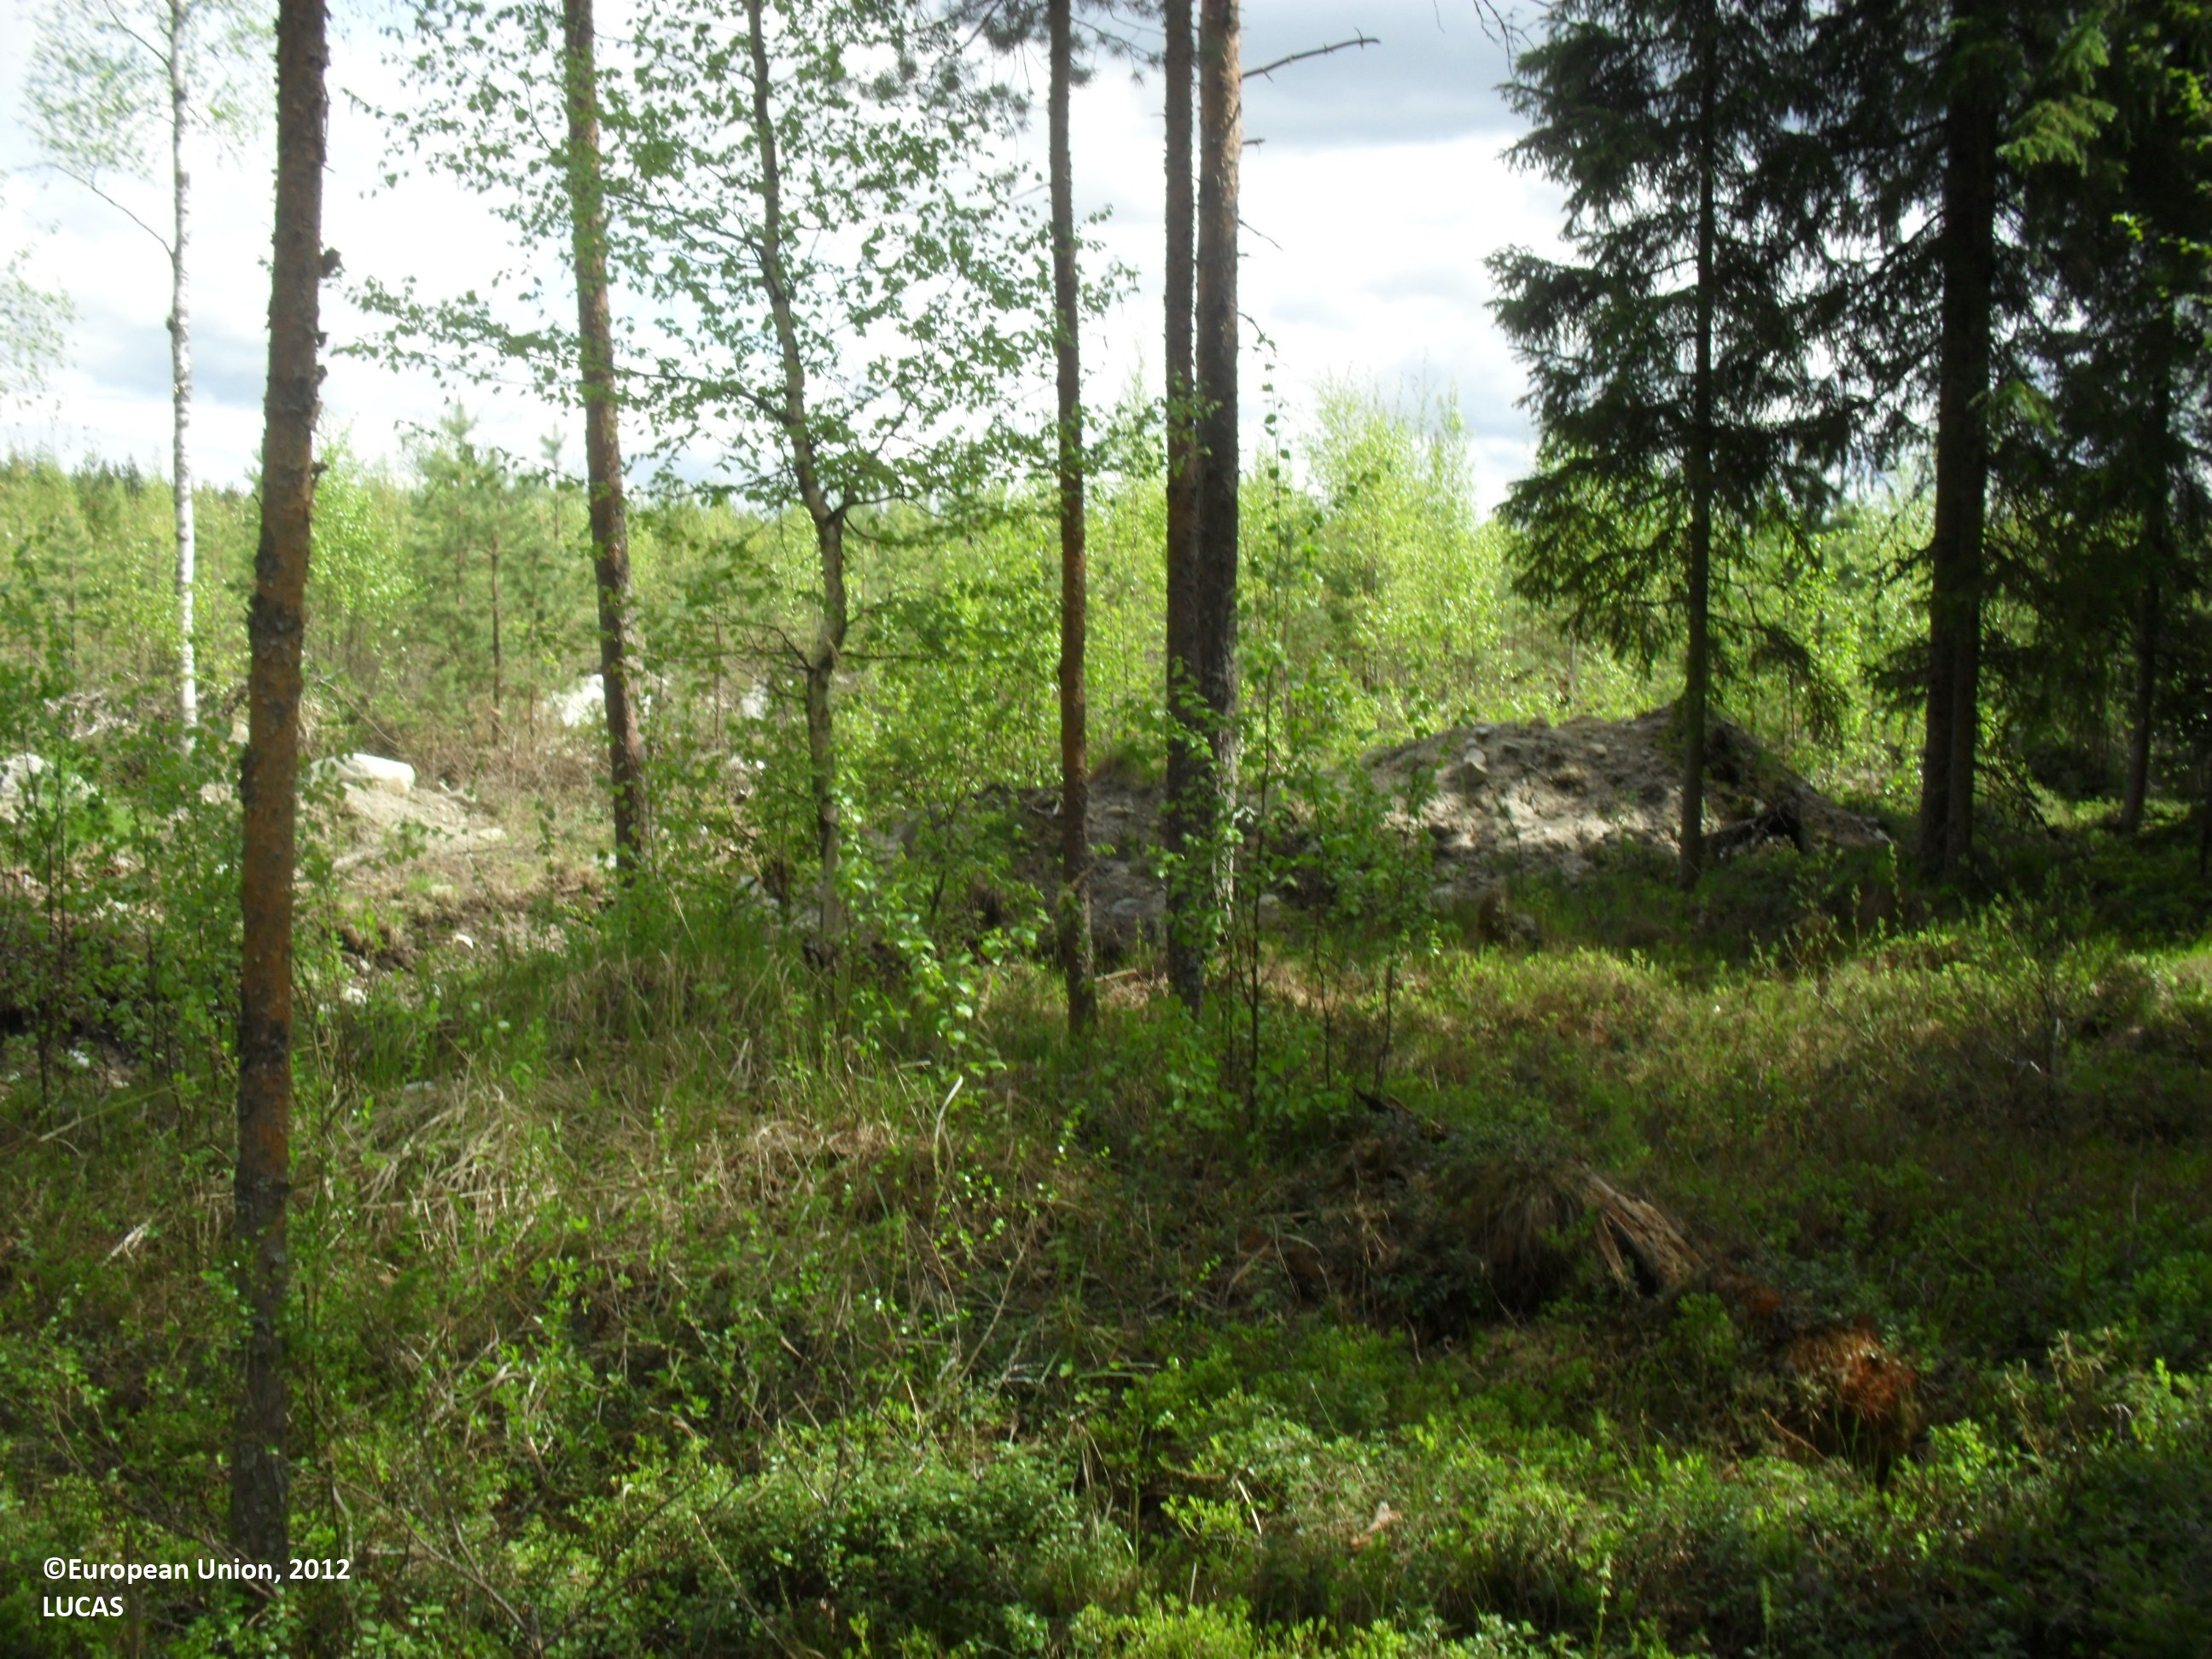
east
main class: Woodland
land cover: Pine dominated coniferous woodland
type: boreal forest
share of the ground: 50 - 75 %
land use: Forestry
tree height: > 5 m
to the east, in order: Pine dominated coniferous woodland; Ditches and canals; Other mixed woodland; Ditches and canals; Other mixed woodland; Grassland with sparse tree/shrub cover; Other mixed woodland; Ditches and canals; Pine dominated coniferous woodland; Ditches and canals; Pine dominated coniferous woodland
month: June
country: FI
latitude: 63.1417
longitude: 23.2549
